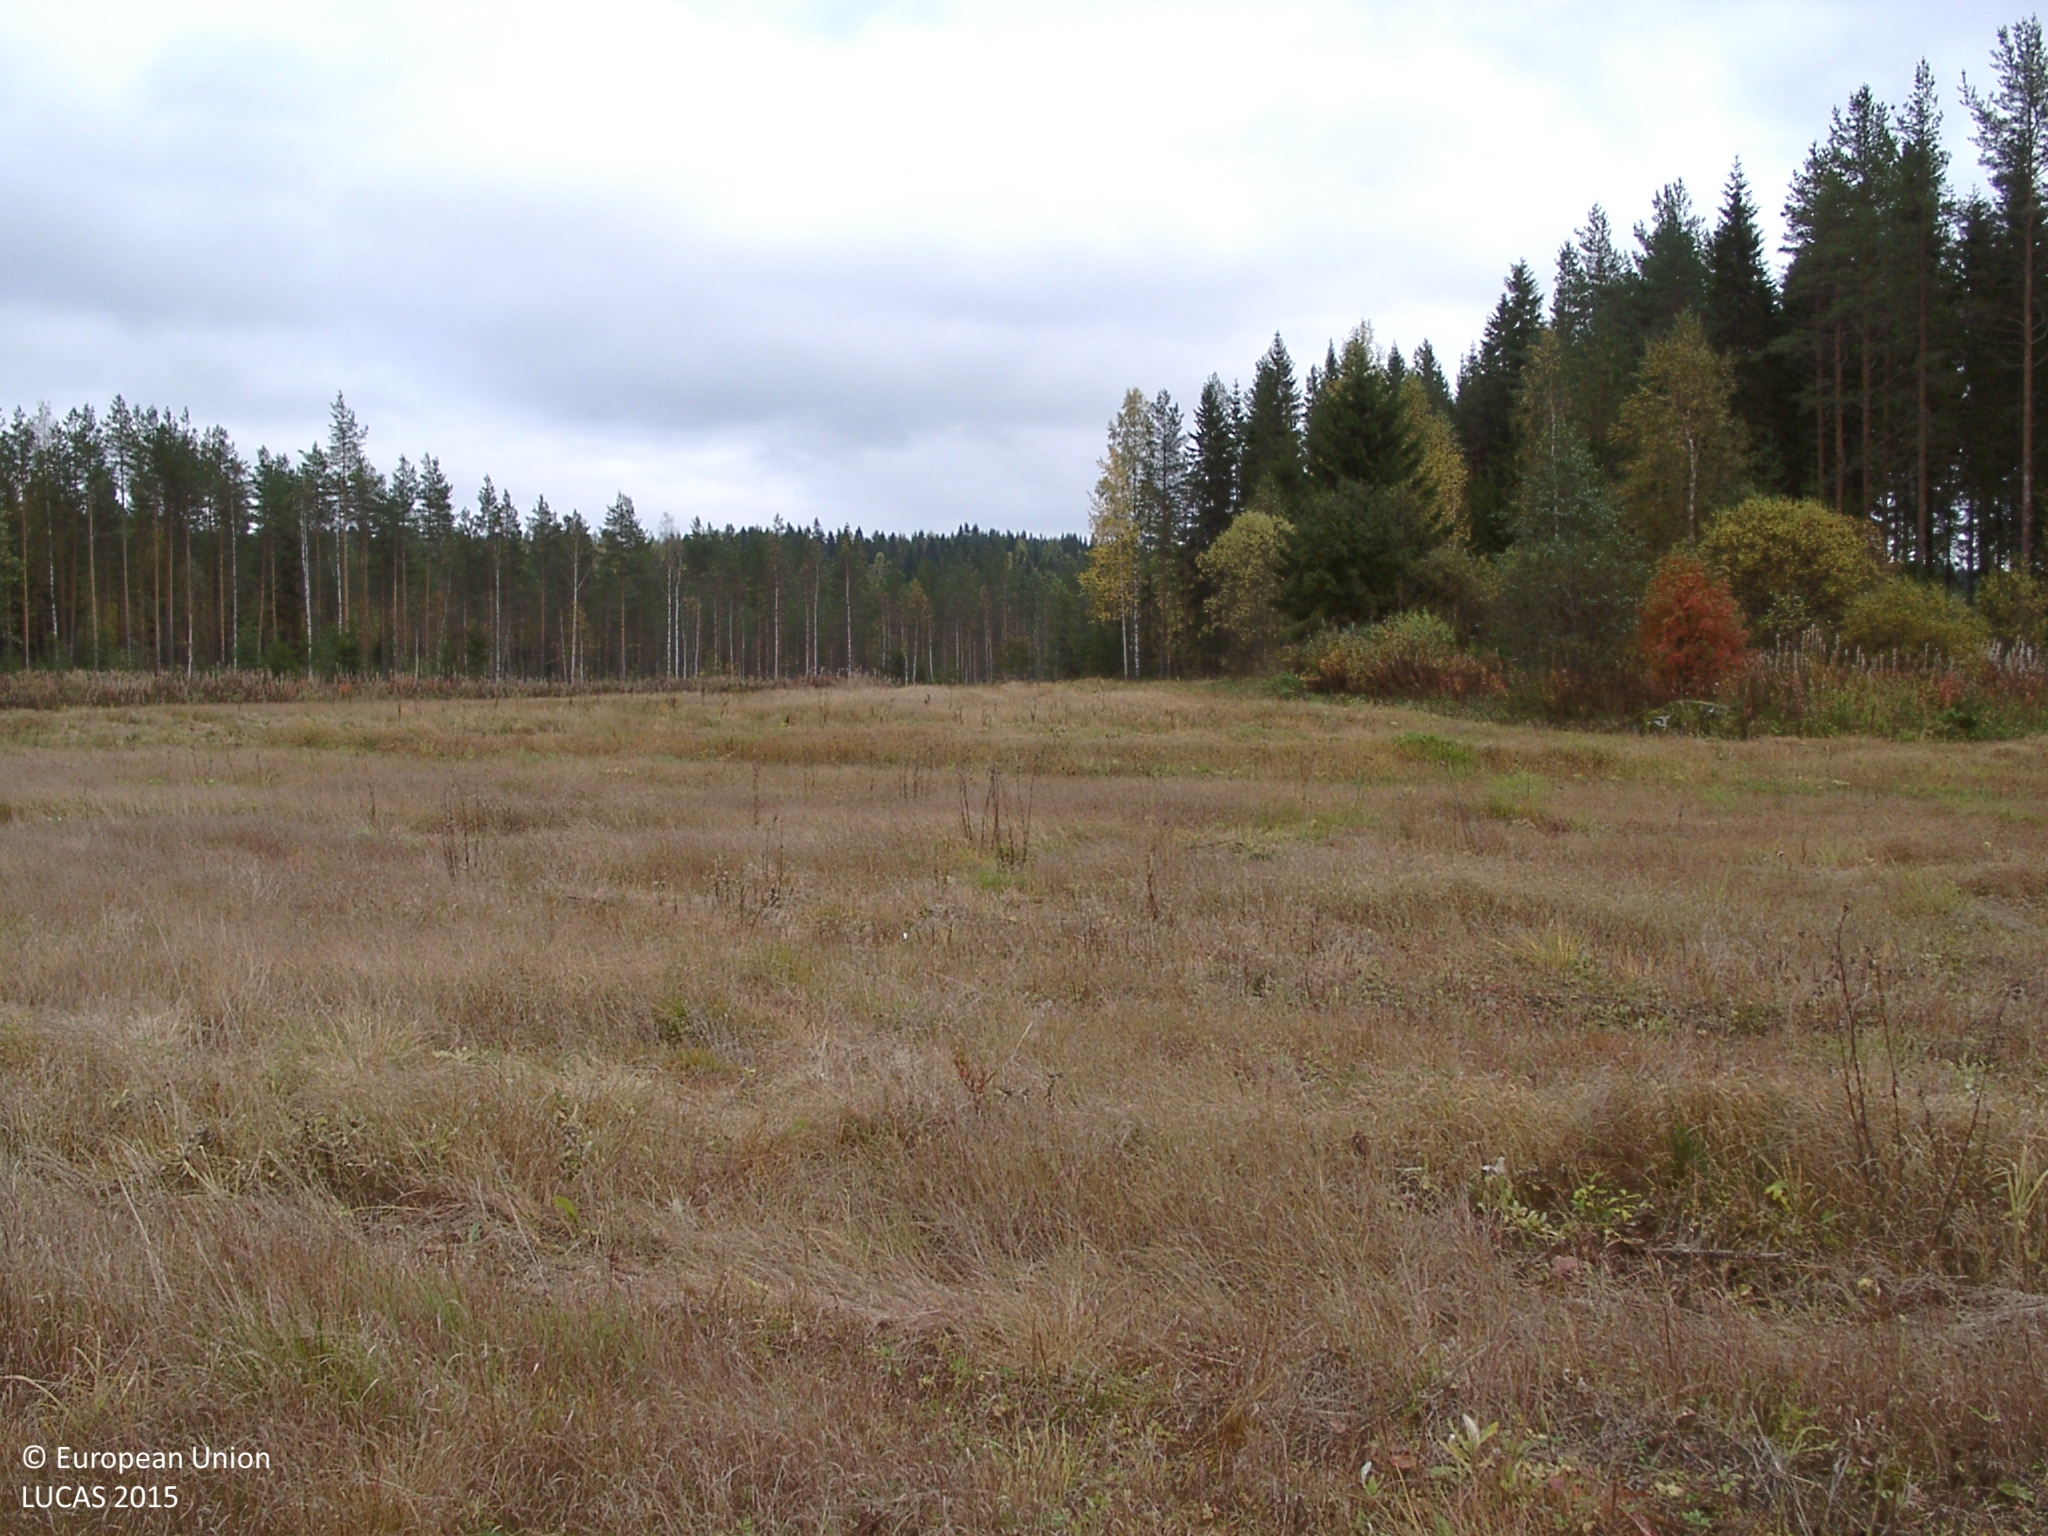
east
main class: Grassland
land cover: Spontaneously vegetated surfaces
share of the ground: > 75 %
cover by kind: herbaceous plants 100 %
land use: Fallow land
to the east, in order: Spontaneously vegetated surfaces; Ditches and canals; Shruby margins; Spontaneously vegetated surfaces; Ditches and canals; Grassland without tree/shrub cover; Paved roads, cycling and walking lanes; Grass margins; Shruby margins; Ditches and canals; Shrubland with sparse tree cover; Shrubland without tree cover; Ponds and wetlands; Other mixed woodland; Pine dominated mixed woodland; Ditches and canals; Pine dominated mixed woodland
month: September
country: FI
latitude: 62.6000
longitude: 25.2788
